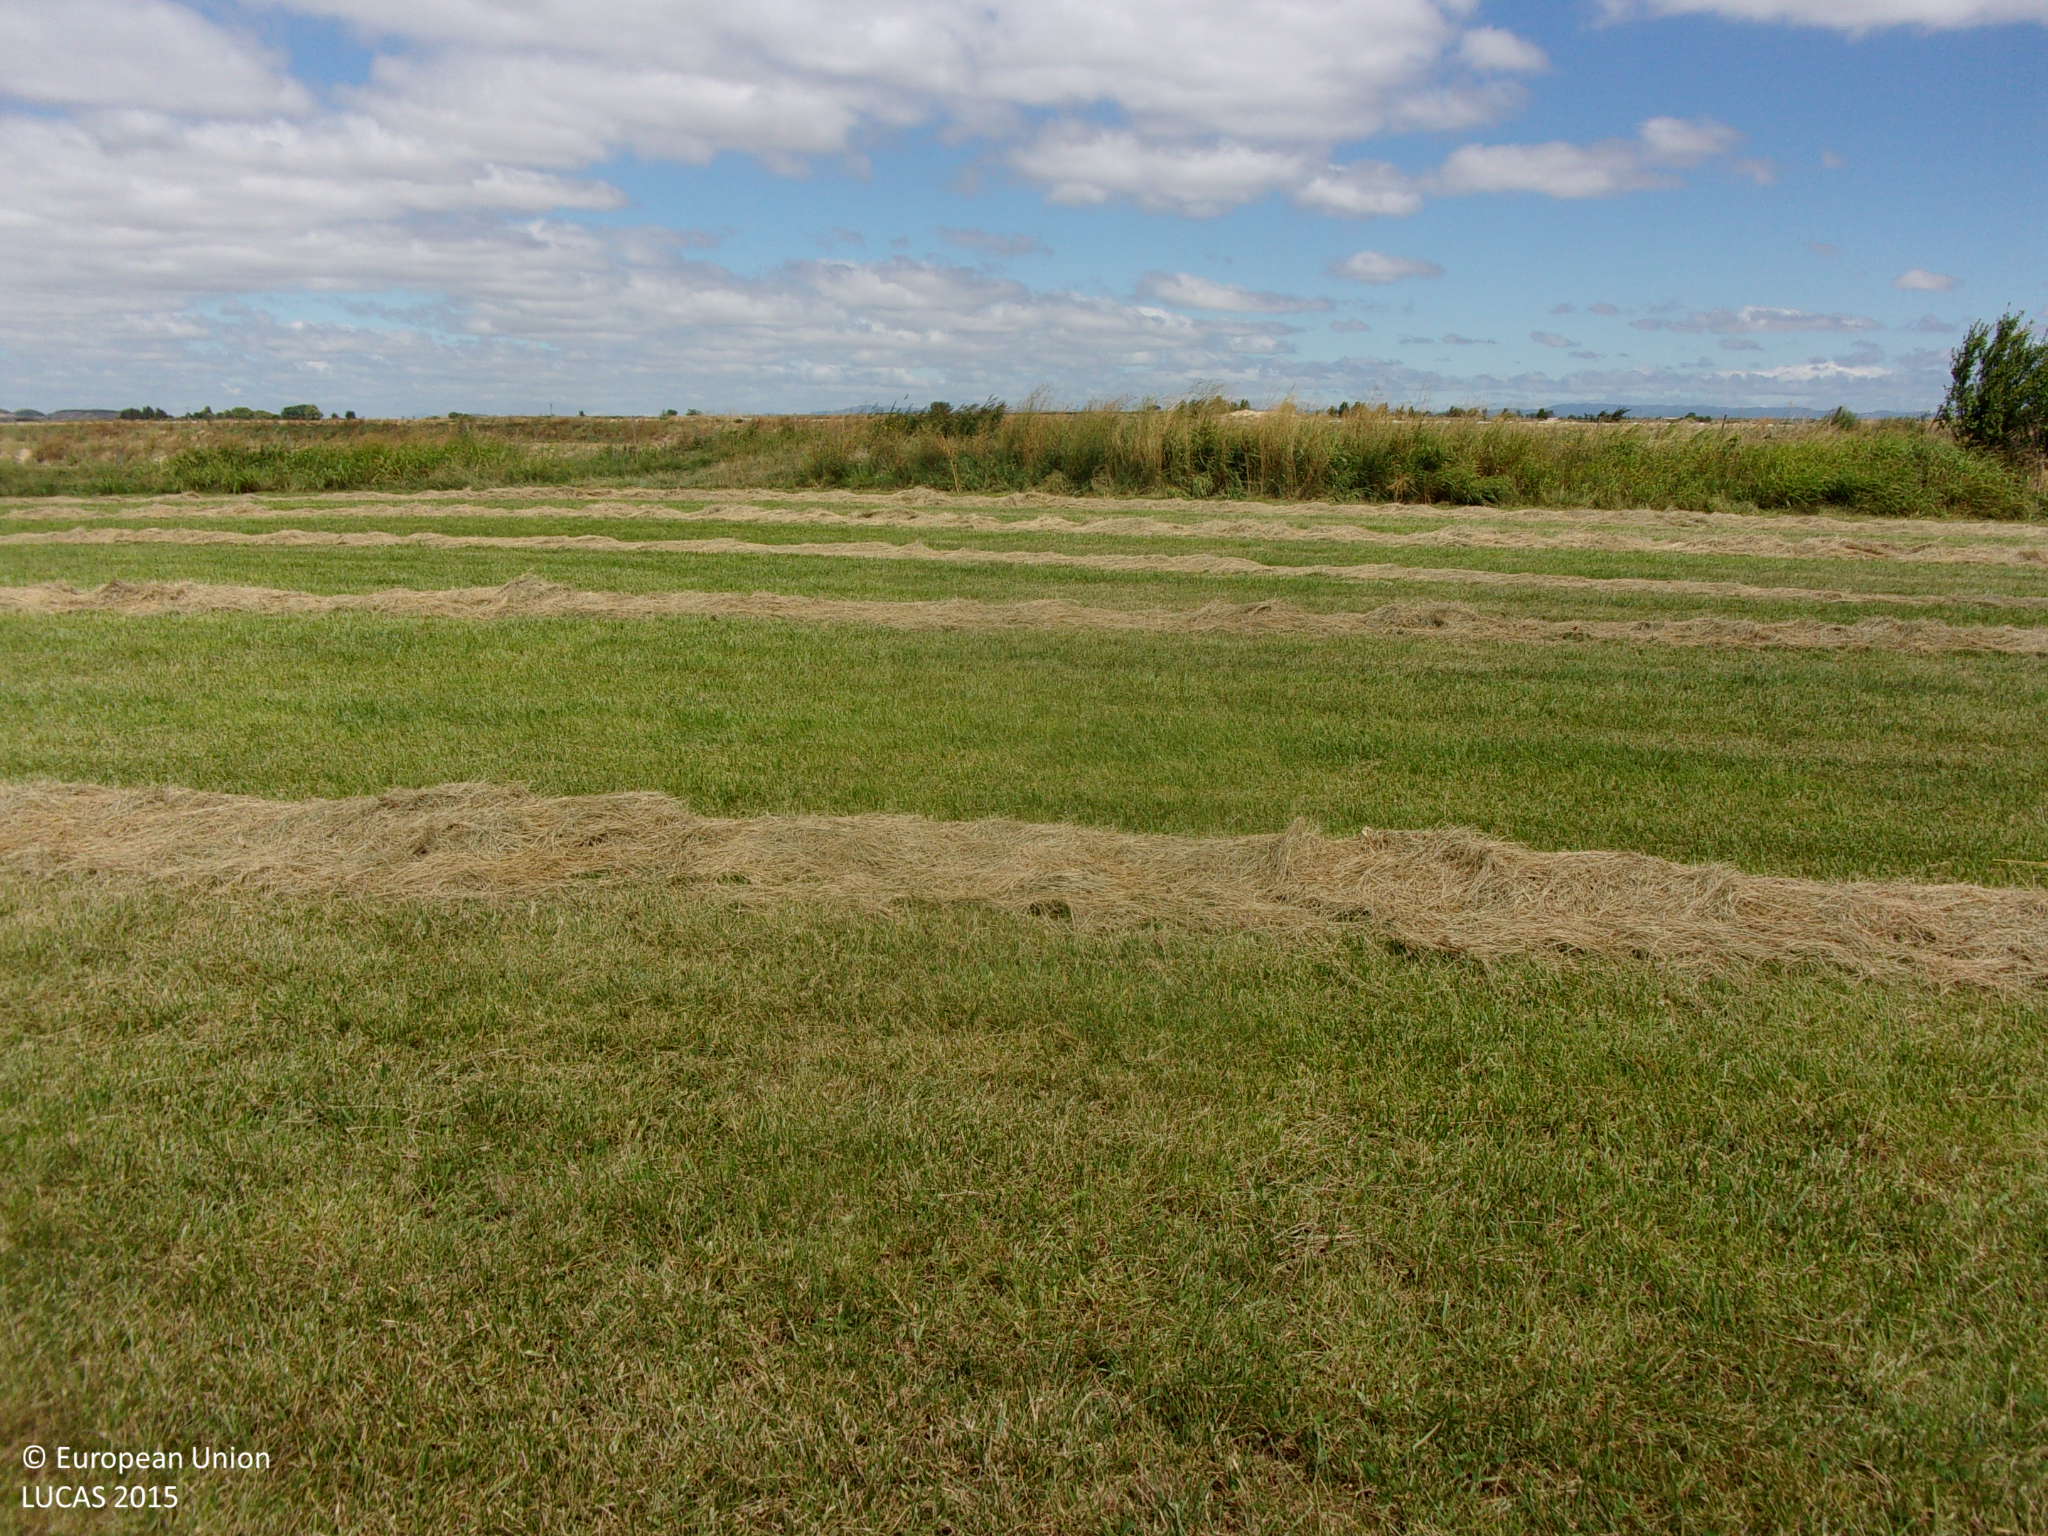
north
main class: Cropland
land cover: Mixed cereals for fodder
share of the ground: > 75 %
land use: Agriculture (excluding fallow land and kitchen gardens)
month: August
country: ES
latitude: 42.1600
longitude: -1.3468
